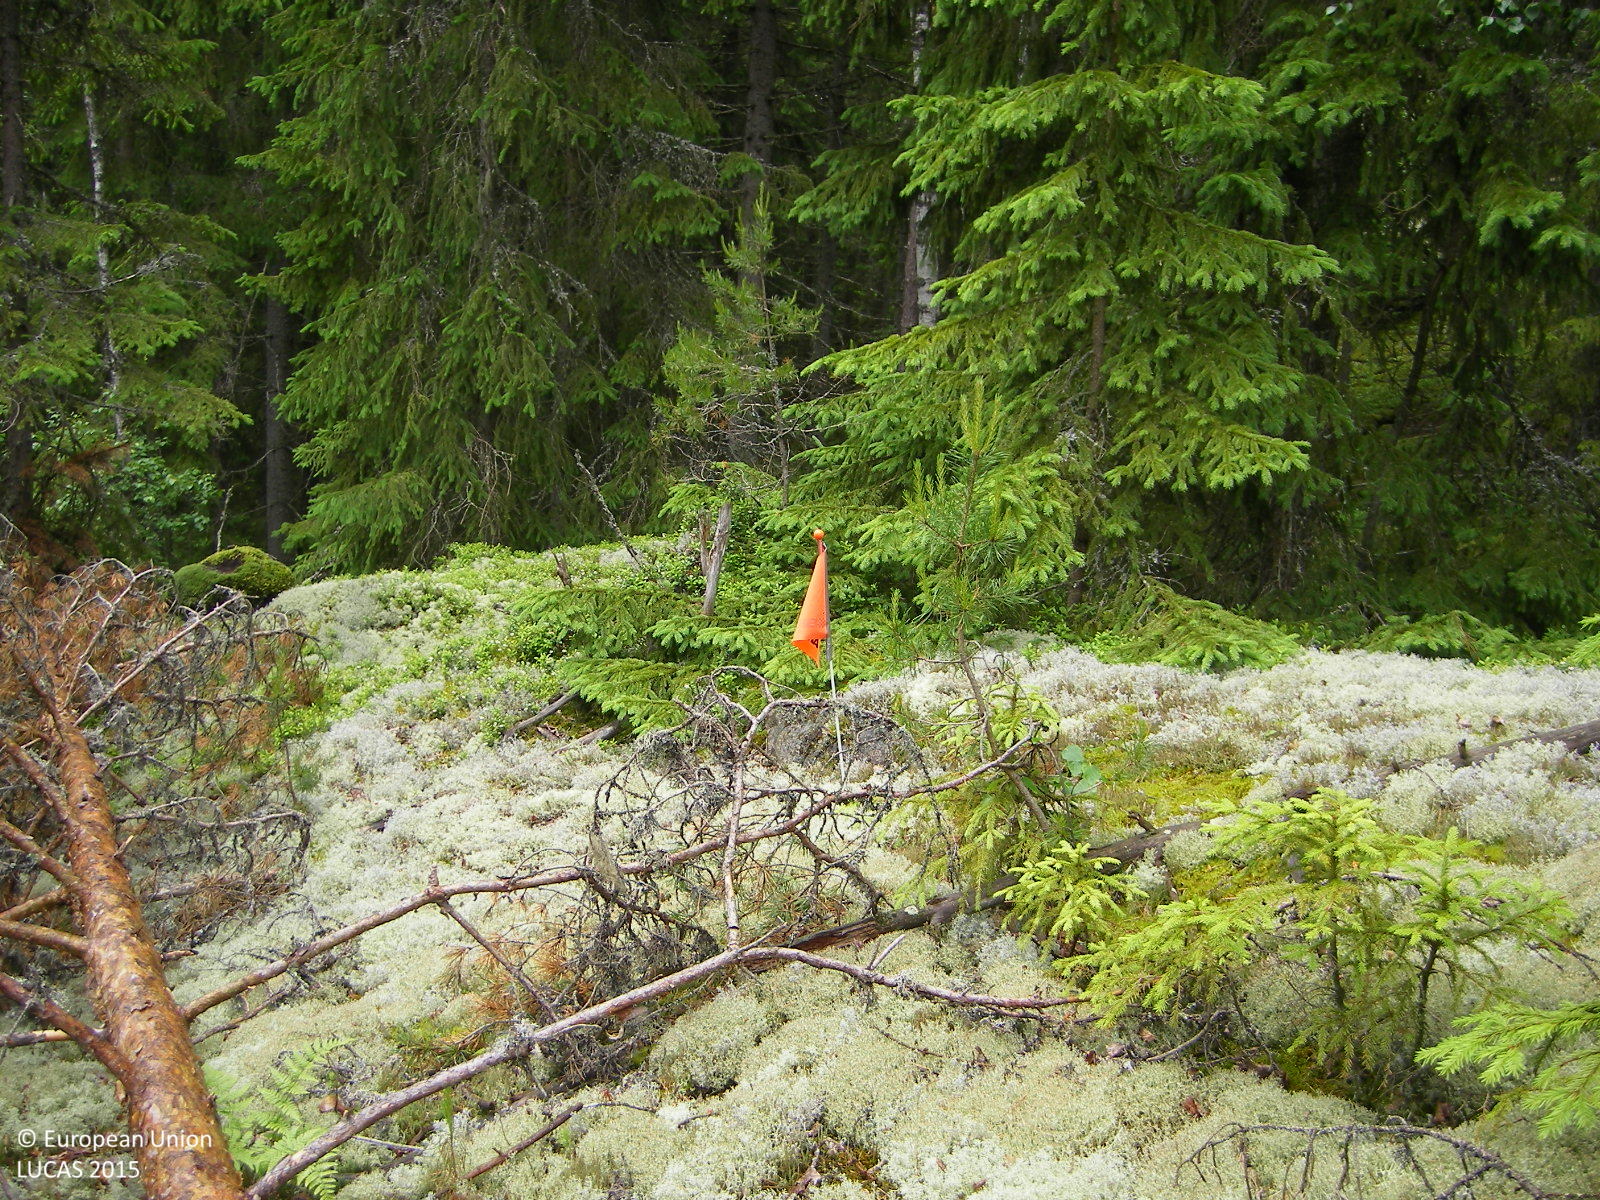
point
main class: Woodland
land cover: Spruce dominated mixed woodland
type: boreal forest
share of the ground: > 75 %
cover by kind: coniferous forest trees 60 %, broadleaved forest trees 25 %, lichens and mosses 10 %, shrubs 5 %
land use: Forestry
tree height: > 5 m
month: June
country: FI
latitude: 60.4020
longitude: 23.3530
